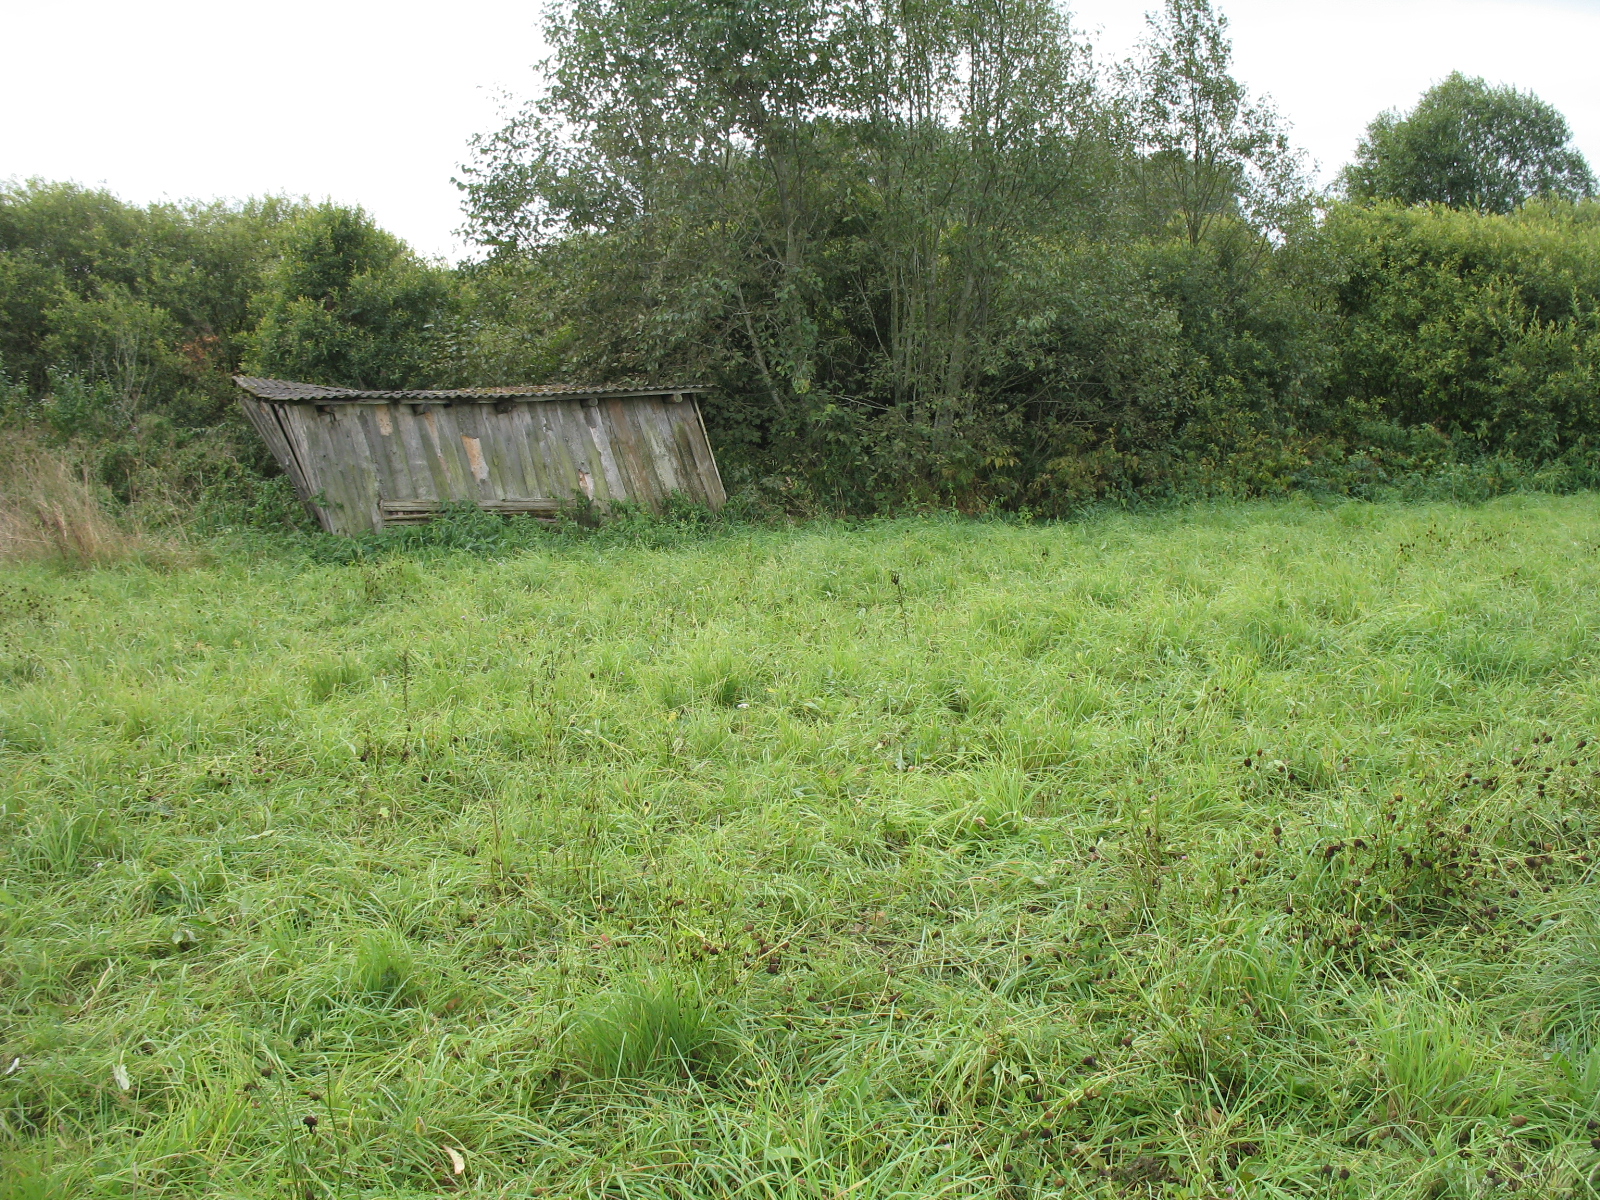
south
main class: Grassland
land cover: Grassland without tree/shrub cover
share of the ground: > 75 %
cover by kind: herbaceous plants 100 %
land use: Agriculture (excluding fallow land and kitchen gardens)
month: September
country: LV
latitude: 56.0419
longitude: 26.1106
